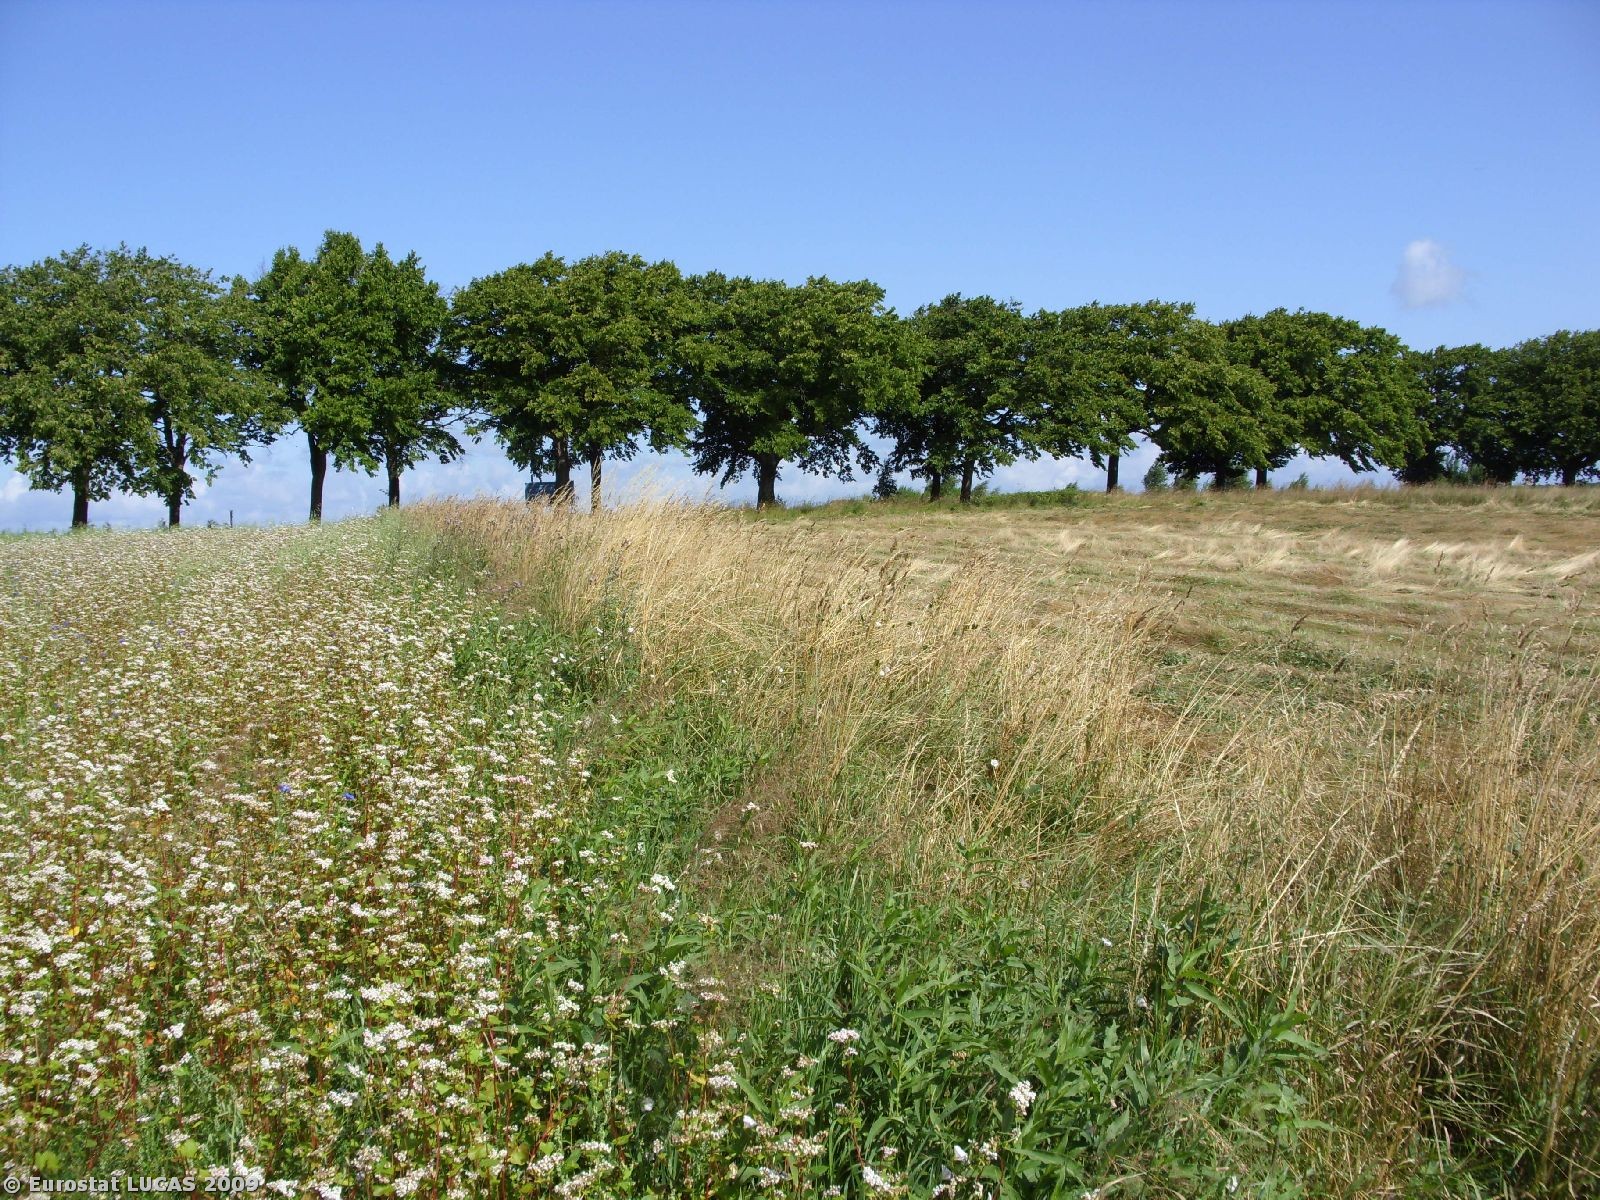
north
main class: Cropland
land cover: Other cereals
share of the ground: > 75 %
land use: Agriculture (excluding fallow land and kitchen gardens)
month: July
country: PL
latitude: 54.2444
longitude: 16.0044
